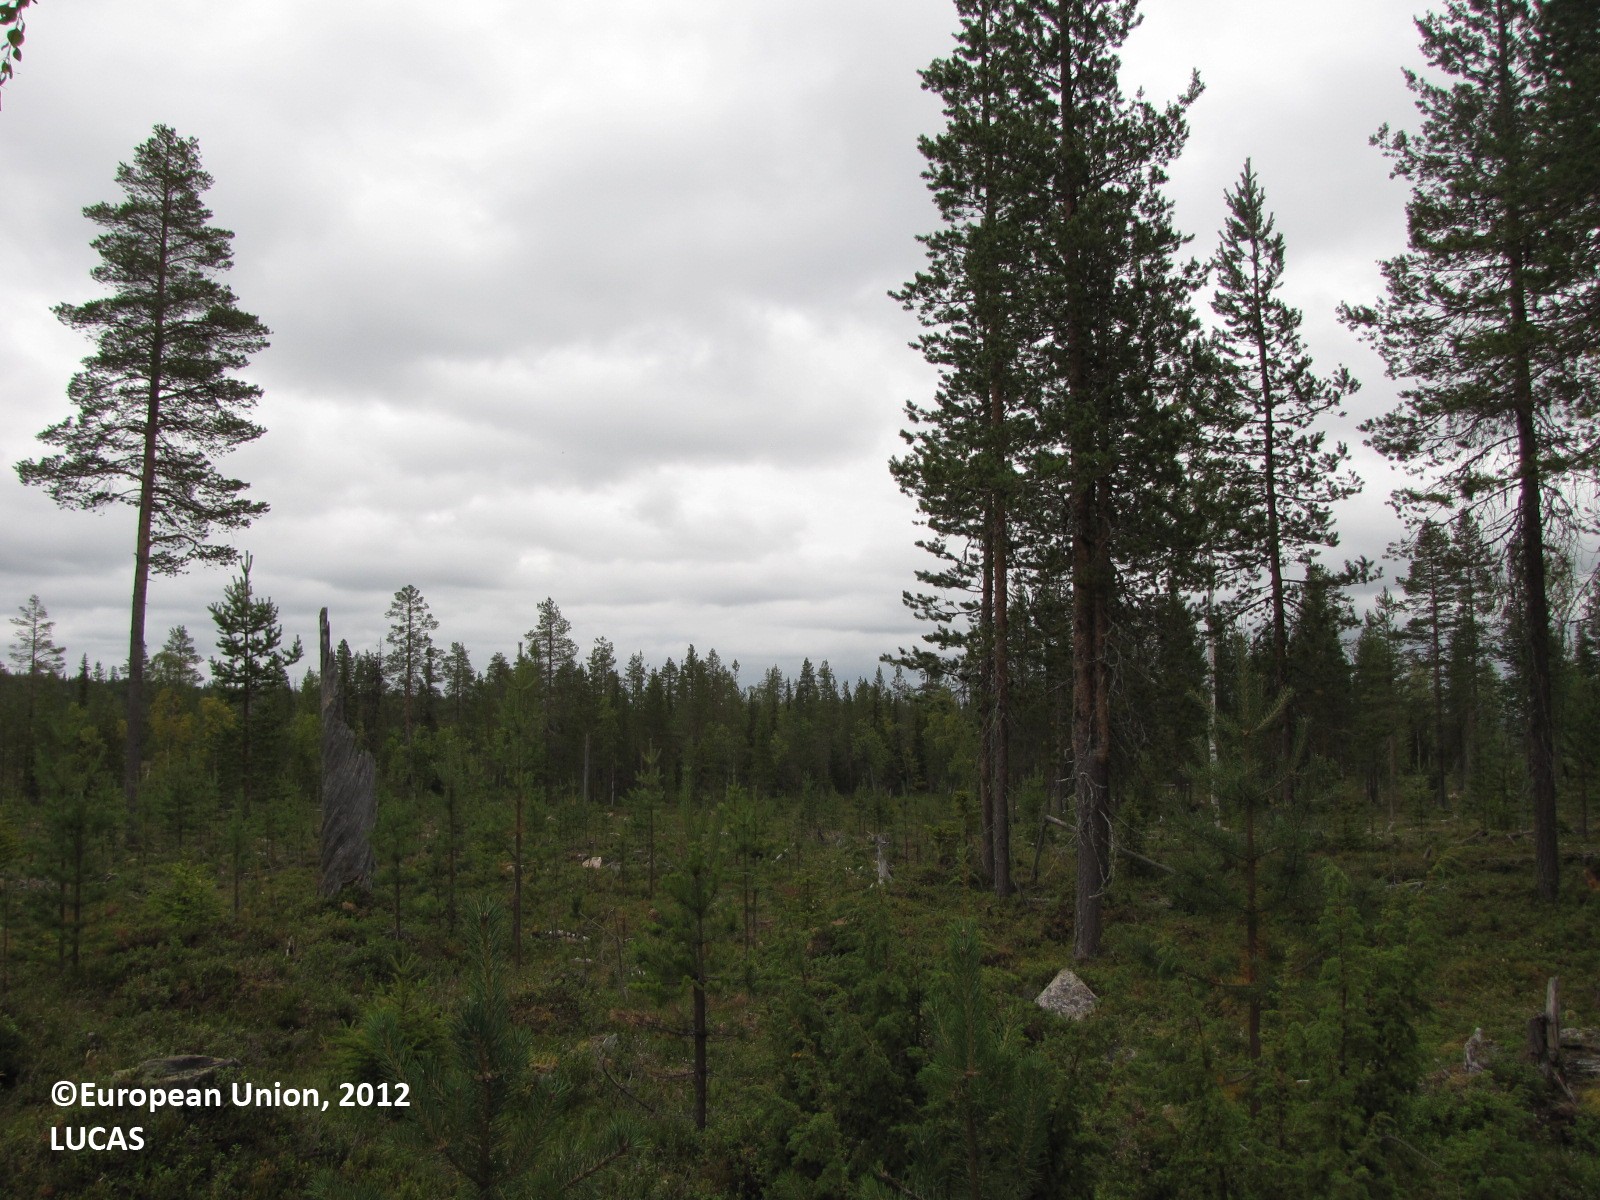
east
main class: Woodland
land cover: Pine dominated mixed woodland
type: boreal forest
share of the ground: 25 - 50 %
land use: Forestry
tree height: > 5 m
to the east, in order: Pine dominated mixed woodland; Pine dominated coniferous woodland; Tracks; Pine dominated mixed woodland
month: August
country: FI
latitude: 67.0910
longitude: 25.3143
